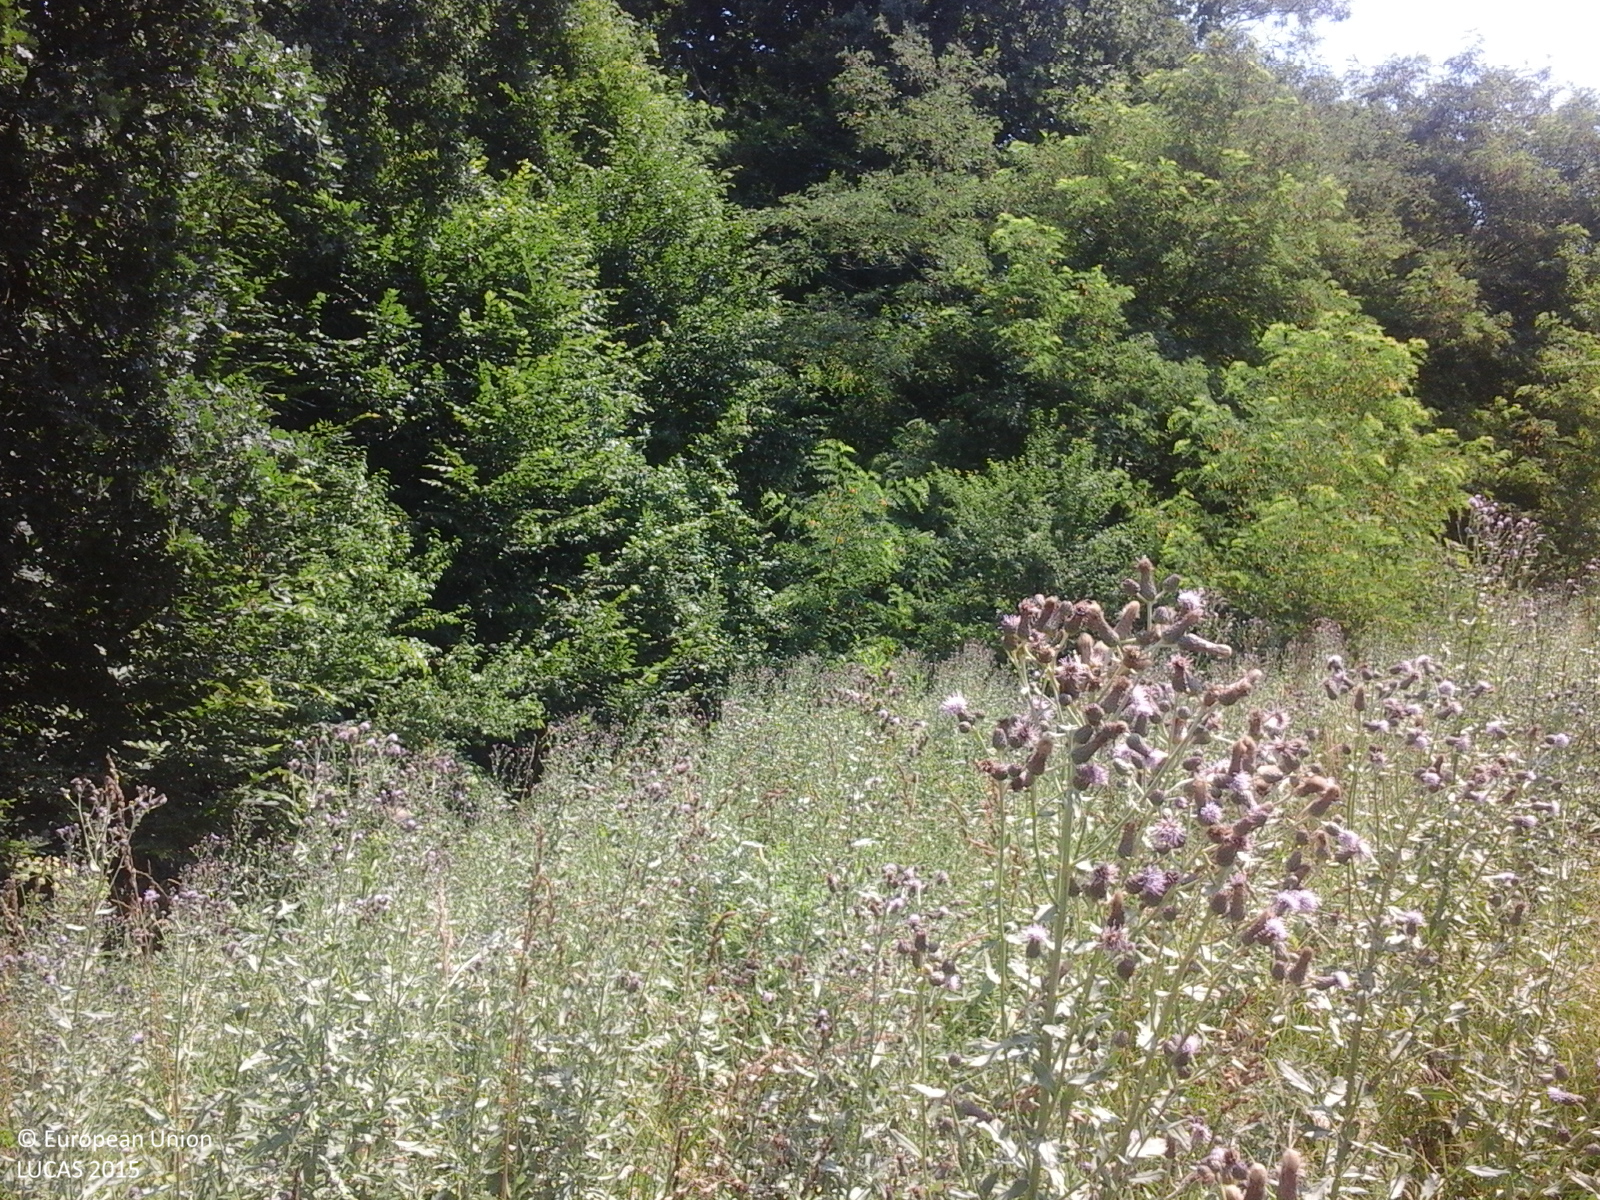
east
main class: Cropland
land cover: Other fruit trees and berries
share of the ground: 25 - 50 %
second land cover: Spontaneously vegetated surfaces
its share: > 75 %
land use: Agriculture (excluding fallow land and kitchen gardens)
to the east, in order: Other fruit trees and berries; Spontaneously vegetated surfaces; Broadleaved woodland; Grassland without tree/shrub cover; Abandoned hedges; Grassland without tree/shrub cover; Broadleaved woodland
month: July
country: RO
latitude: 45.0865
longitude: 24.4703
